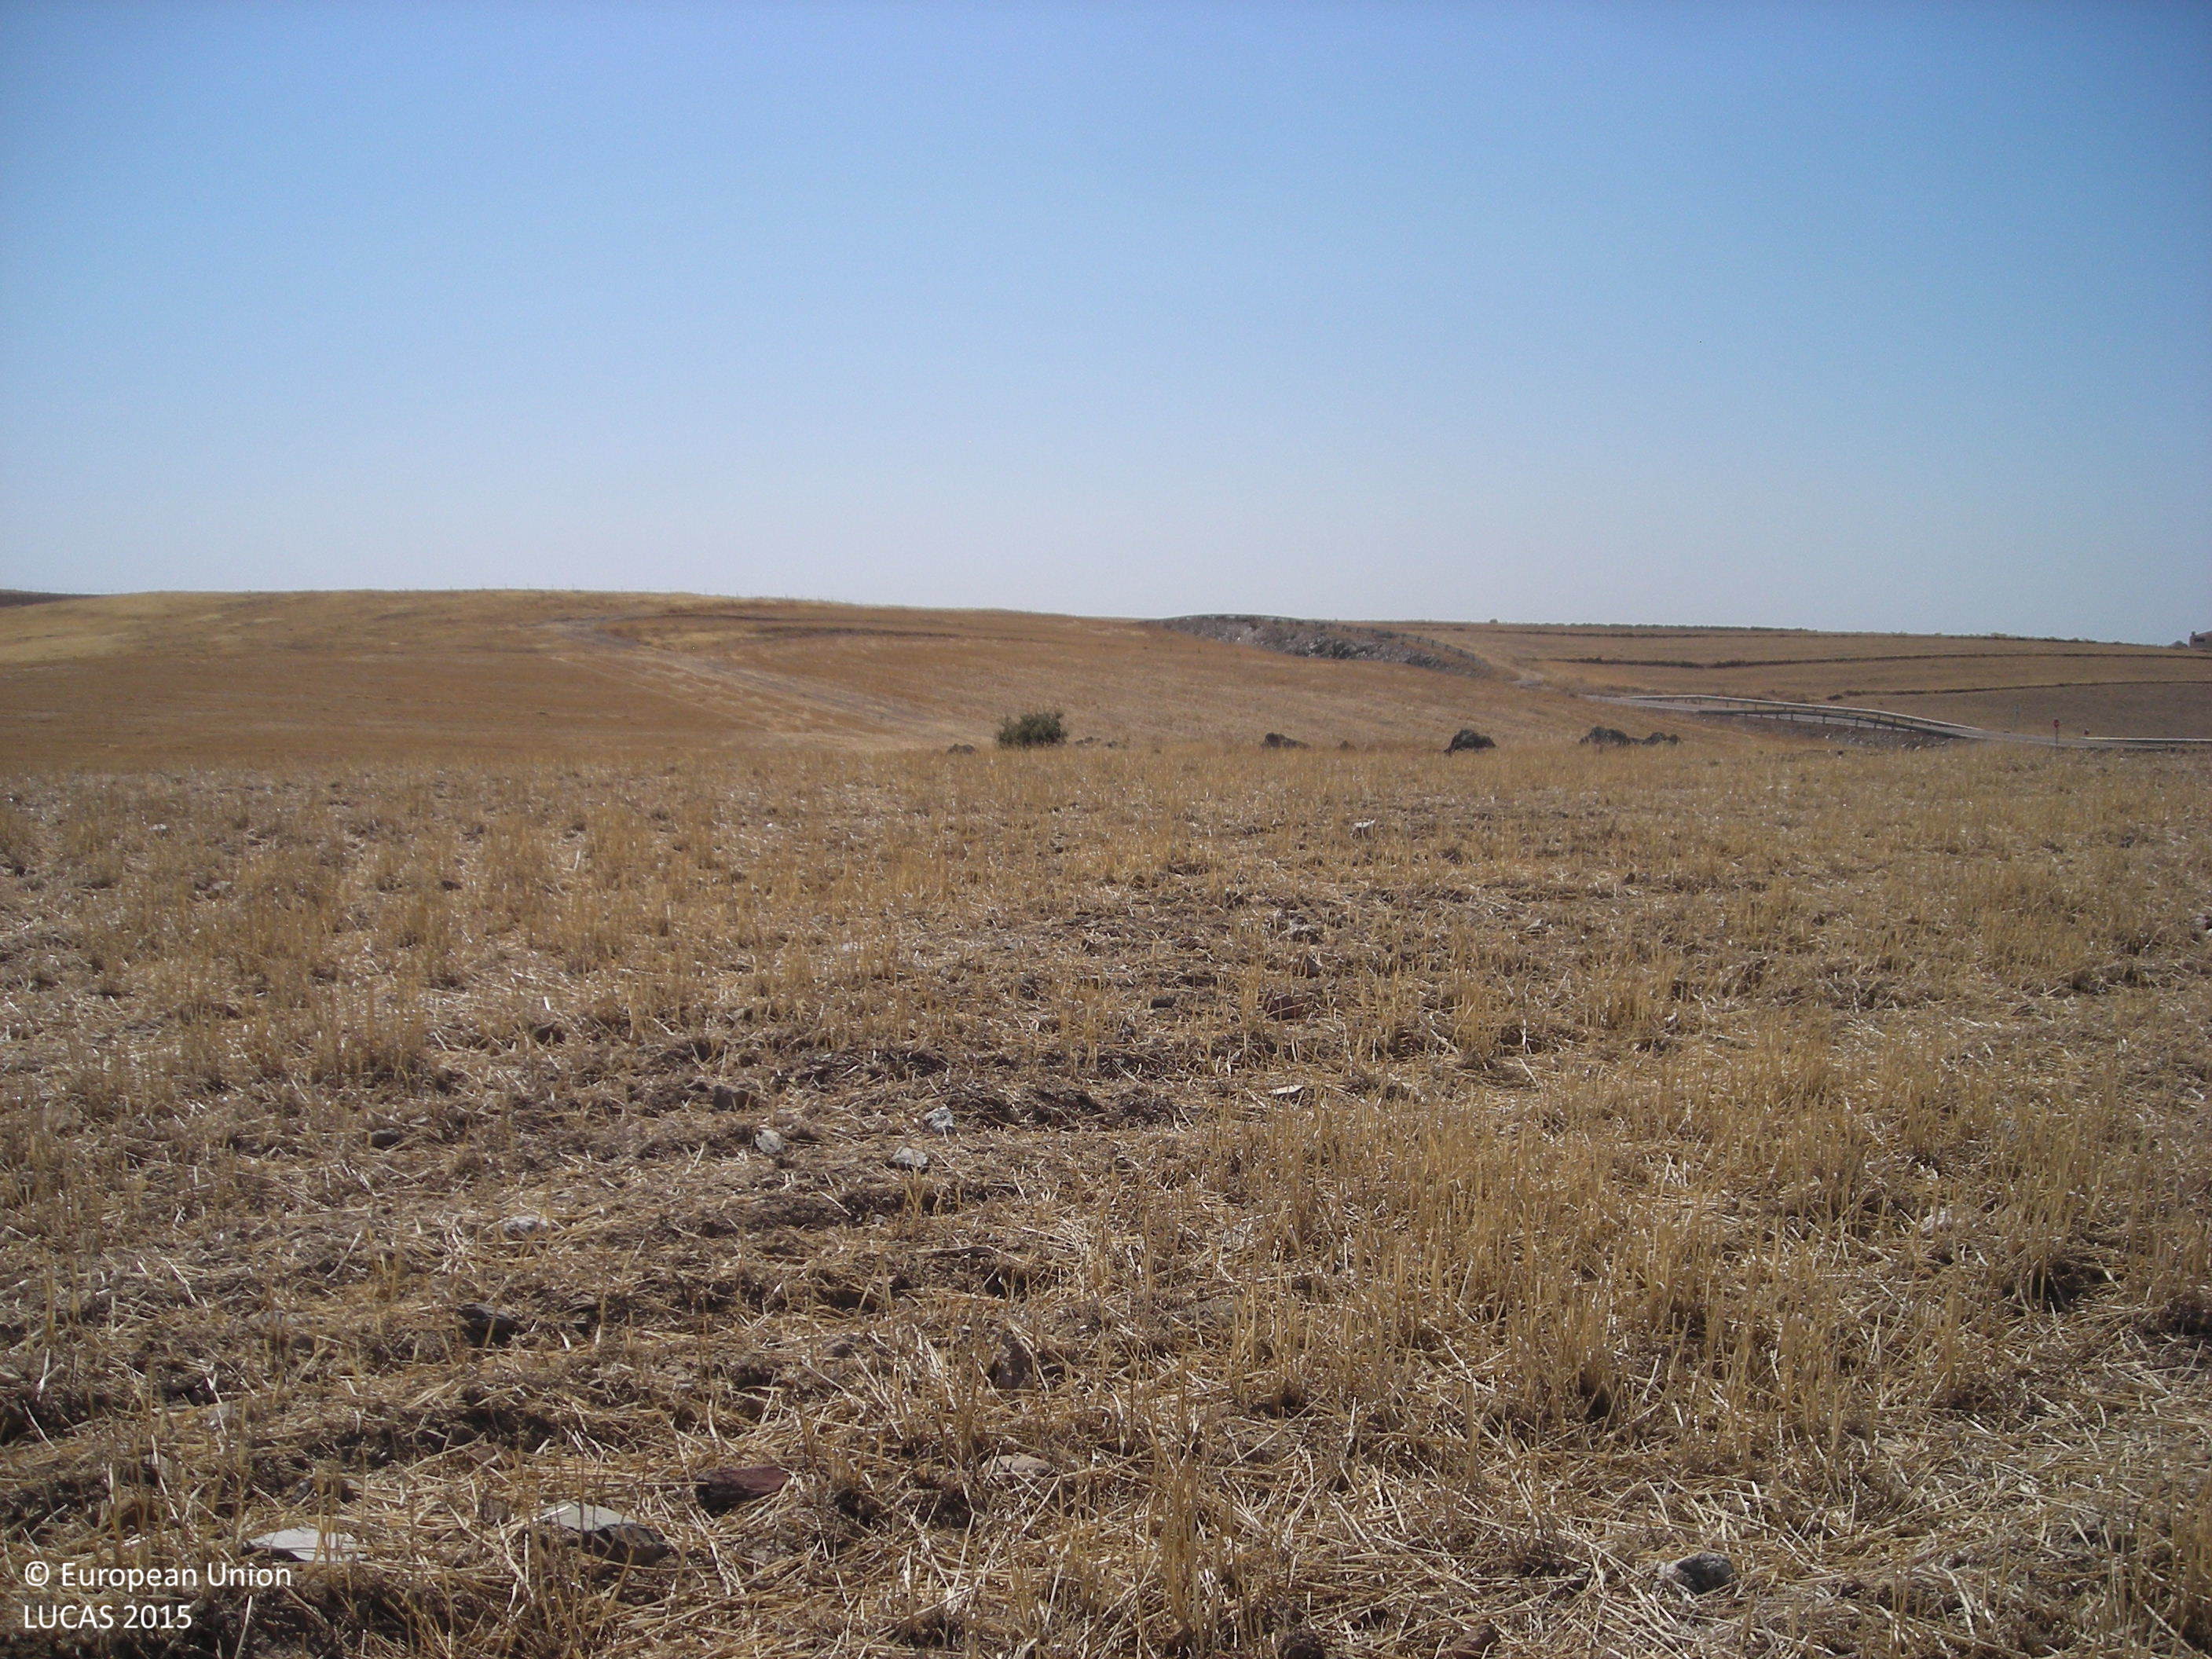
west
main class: Cropland
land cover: Common wheat
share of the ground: > 75 %
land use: Agriculture (excluding fallow land and kitchen gardens)
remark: Harvested field
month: July
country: ES
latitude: 38.9250
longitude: -5.6748
